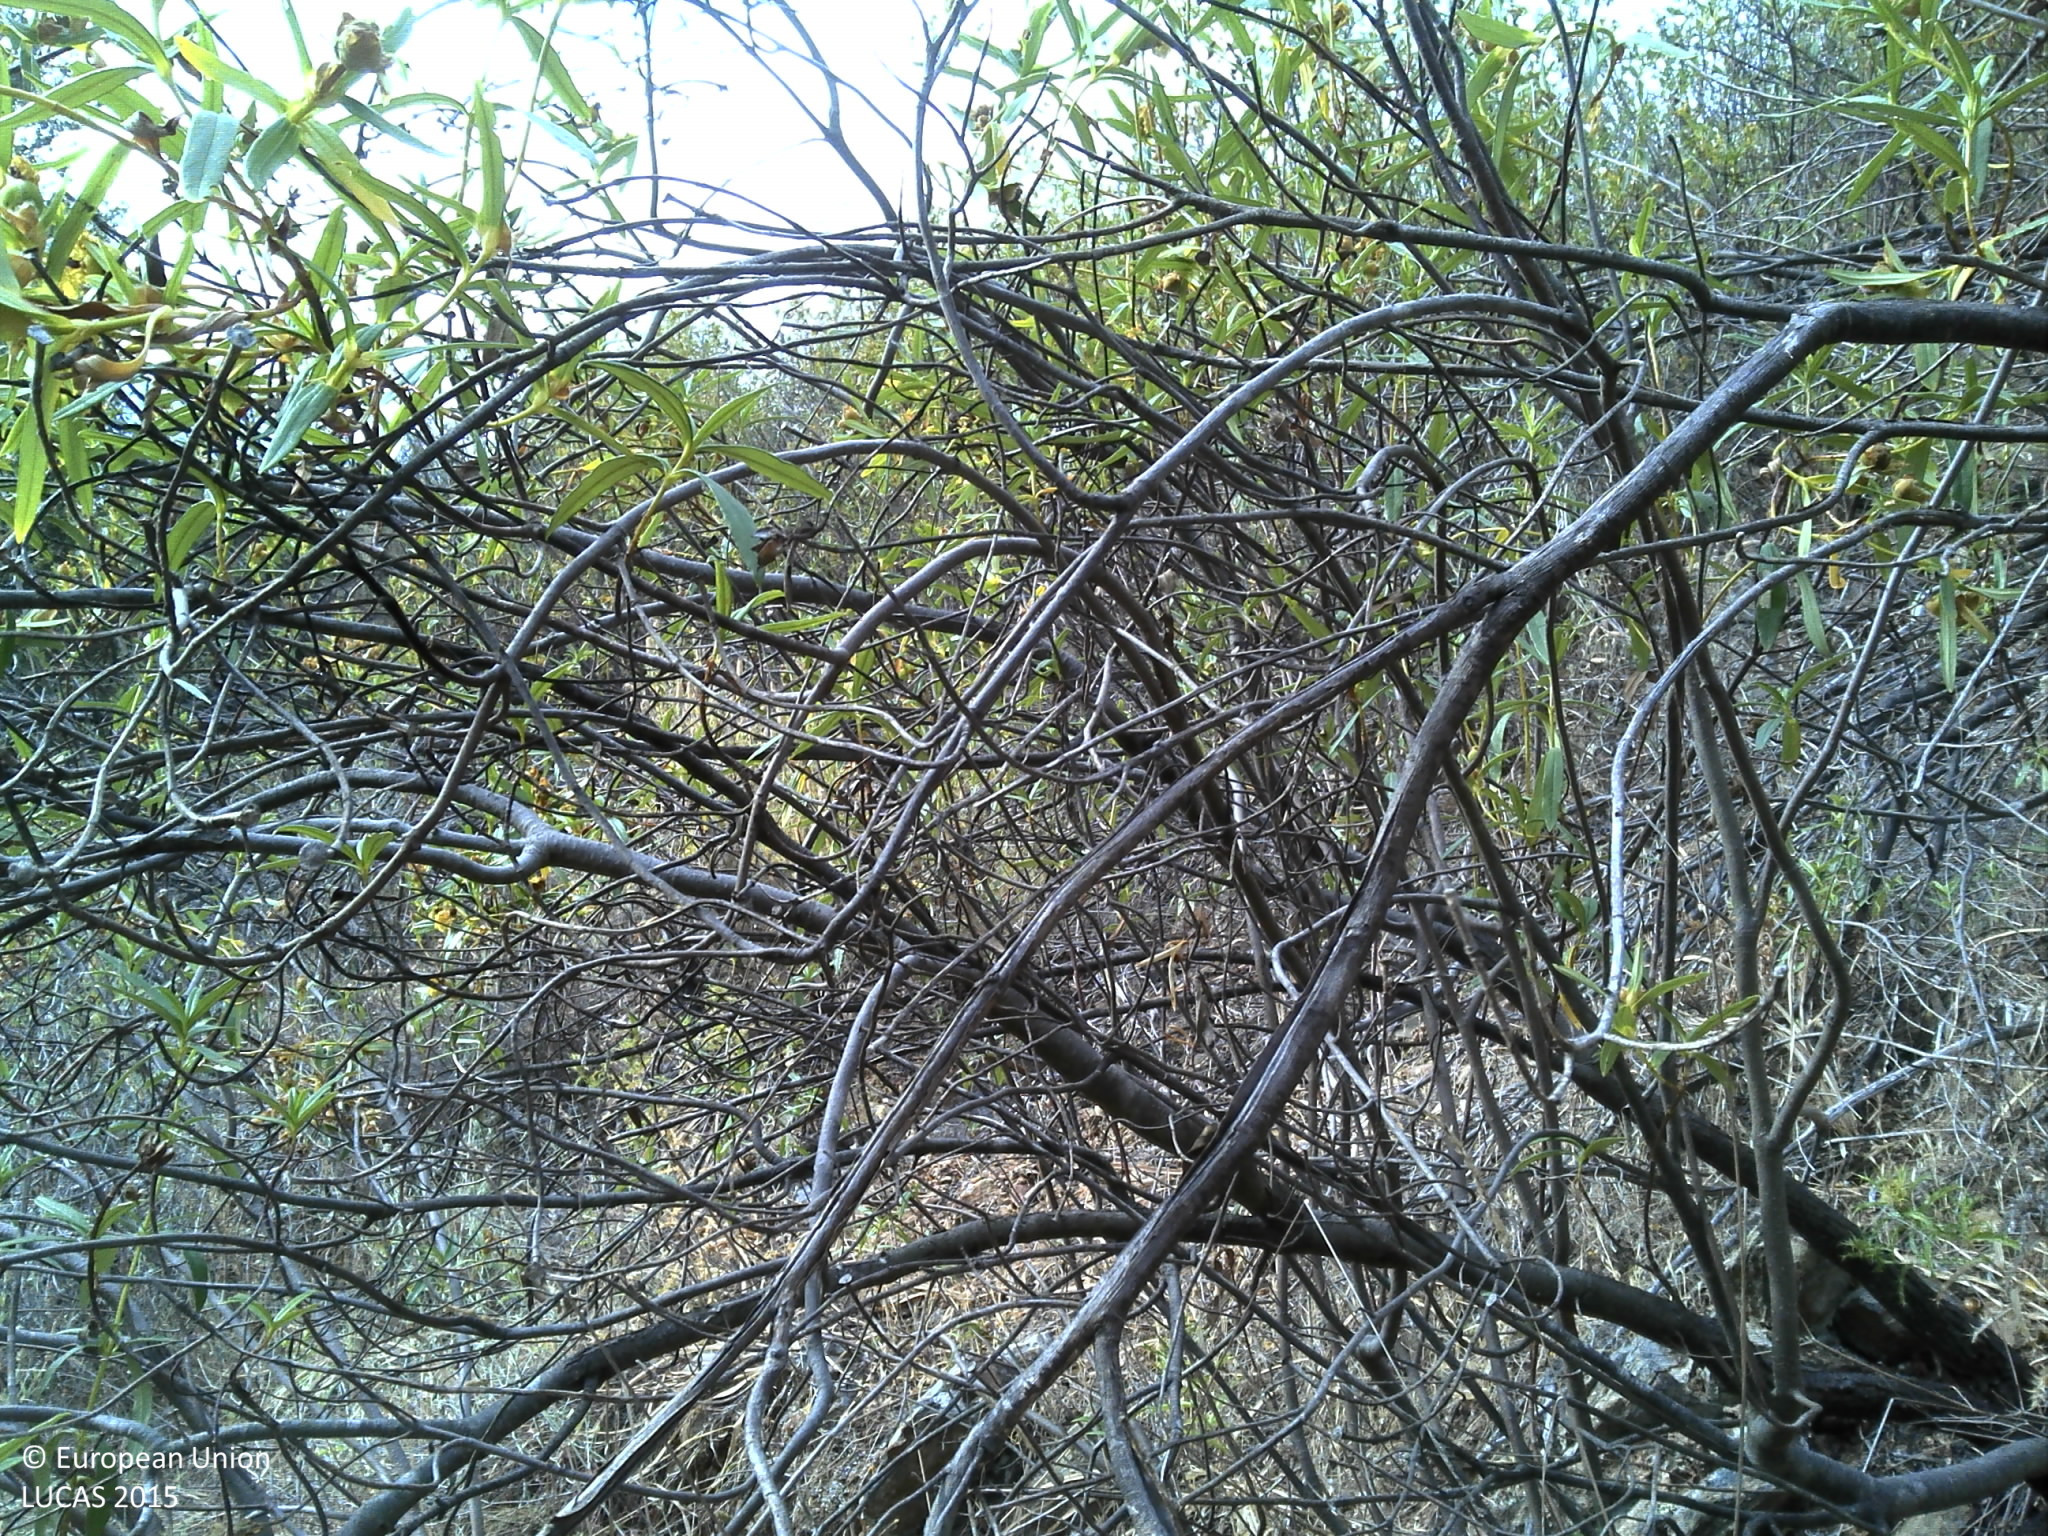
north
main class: Shrubland
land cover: Shrubland without tree cover
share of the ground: > 75 %
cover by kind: shrubs 100 %
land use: Abandoned areas
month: June
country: PT
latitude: 37.2749
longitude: -7.7038
